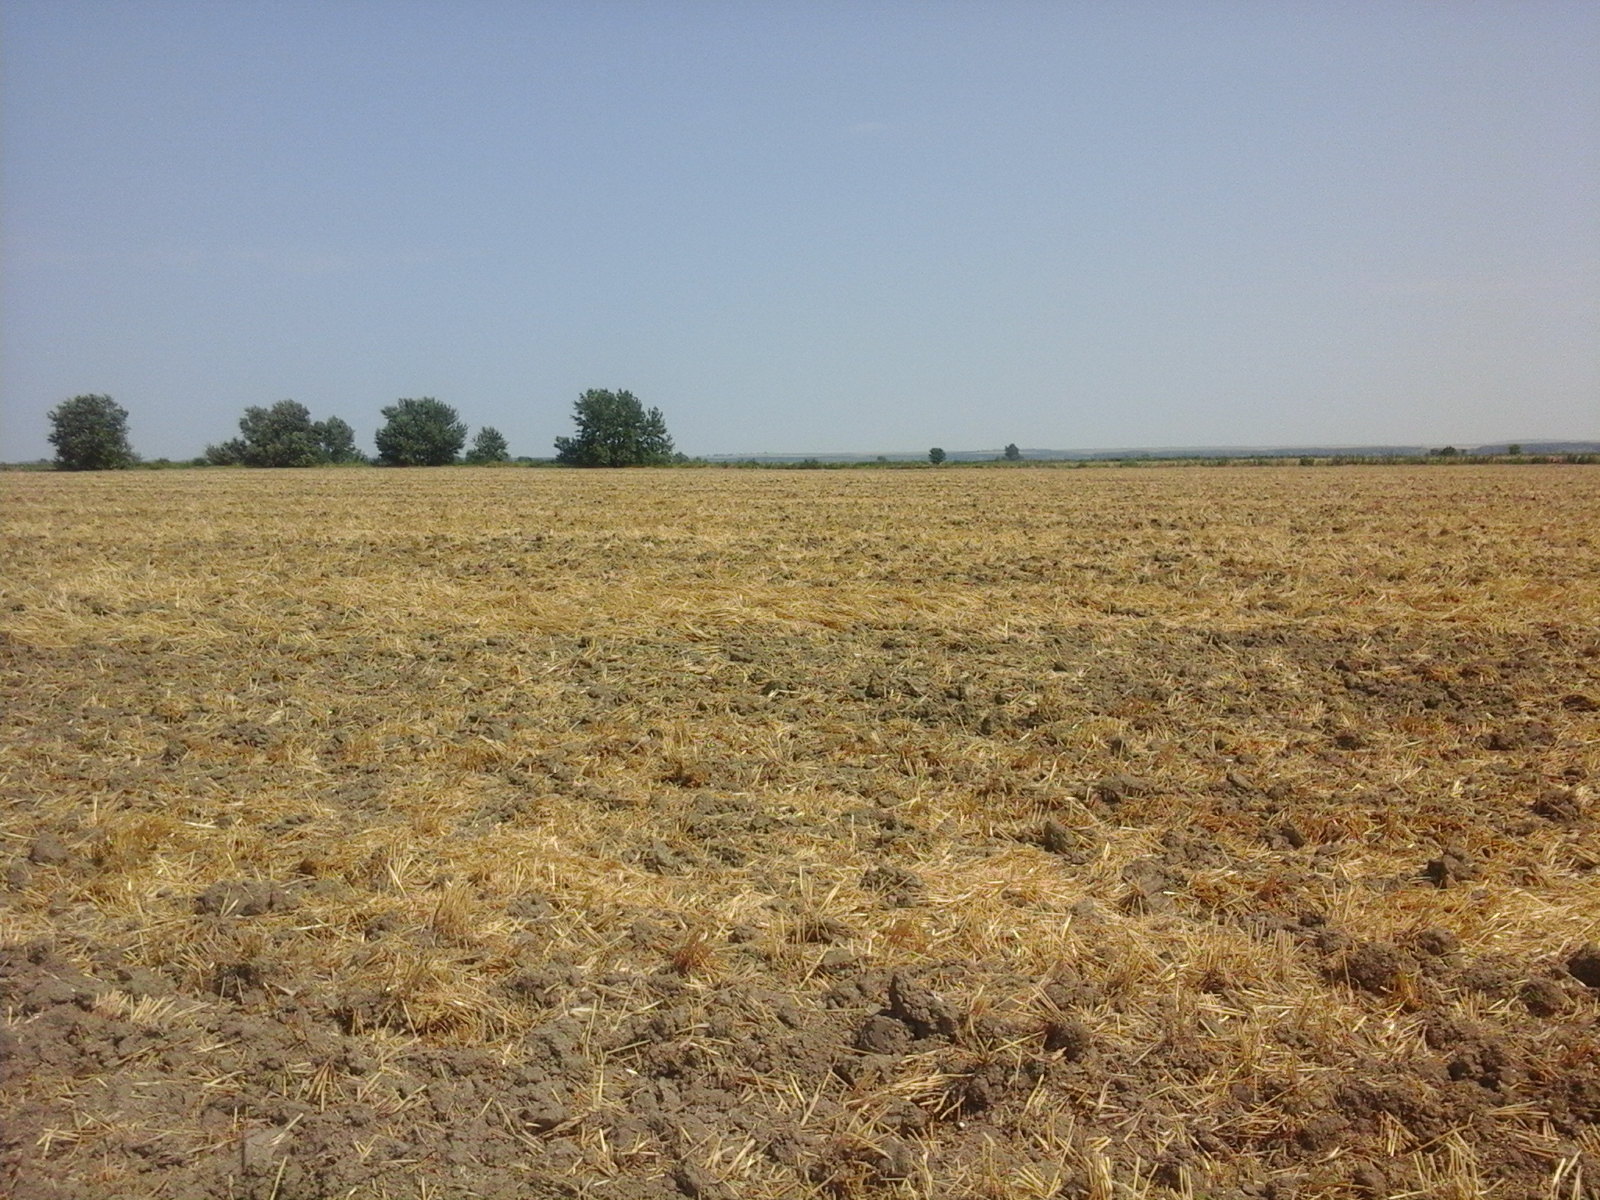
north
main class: Cropland
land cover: Common wheat
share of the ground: 25 - 50 %
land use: Agriculture (excluding fallow land and kitchen gardens)
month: July
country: RO
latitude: 44.4285
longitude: 28.0592
